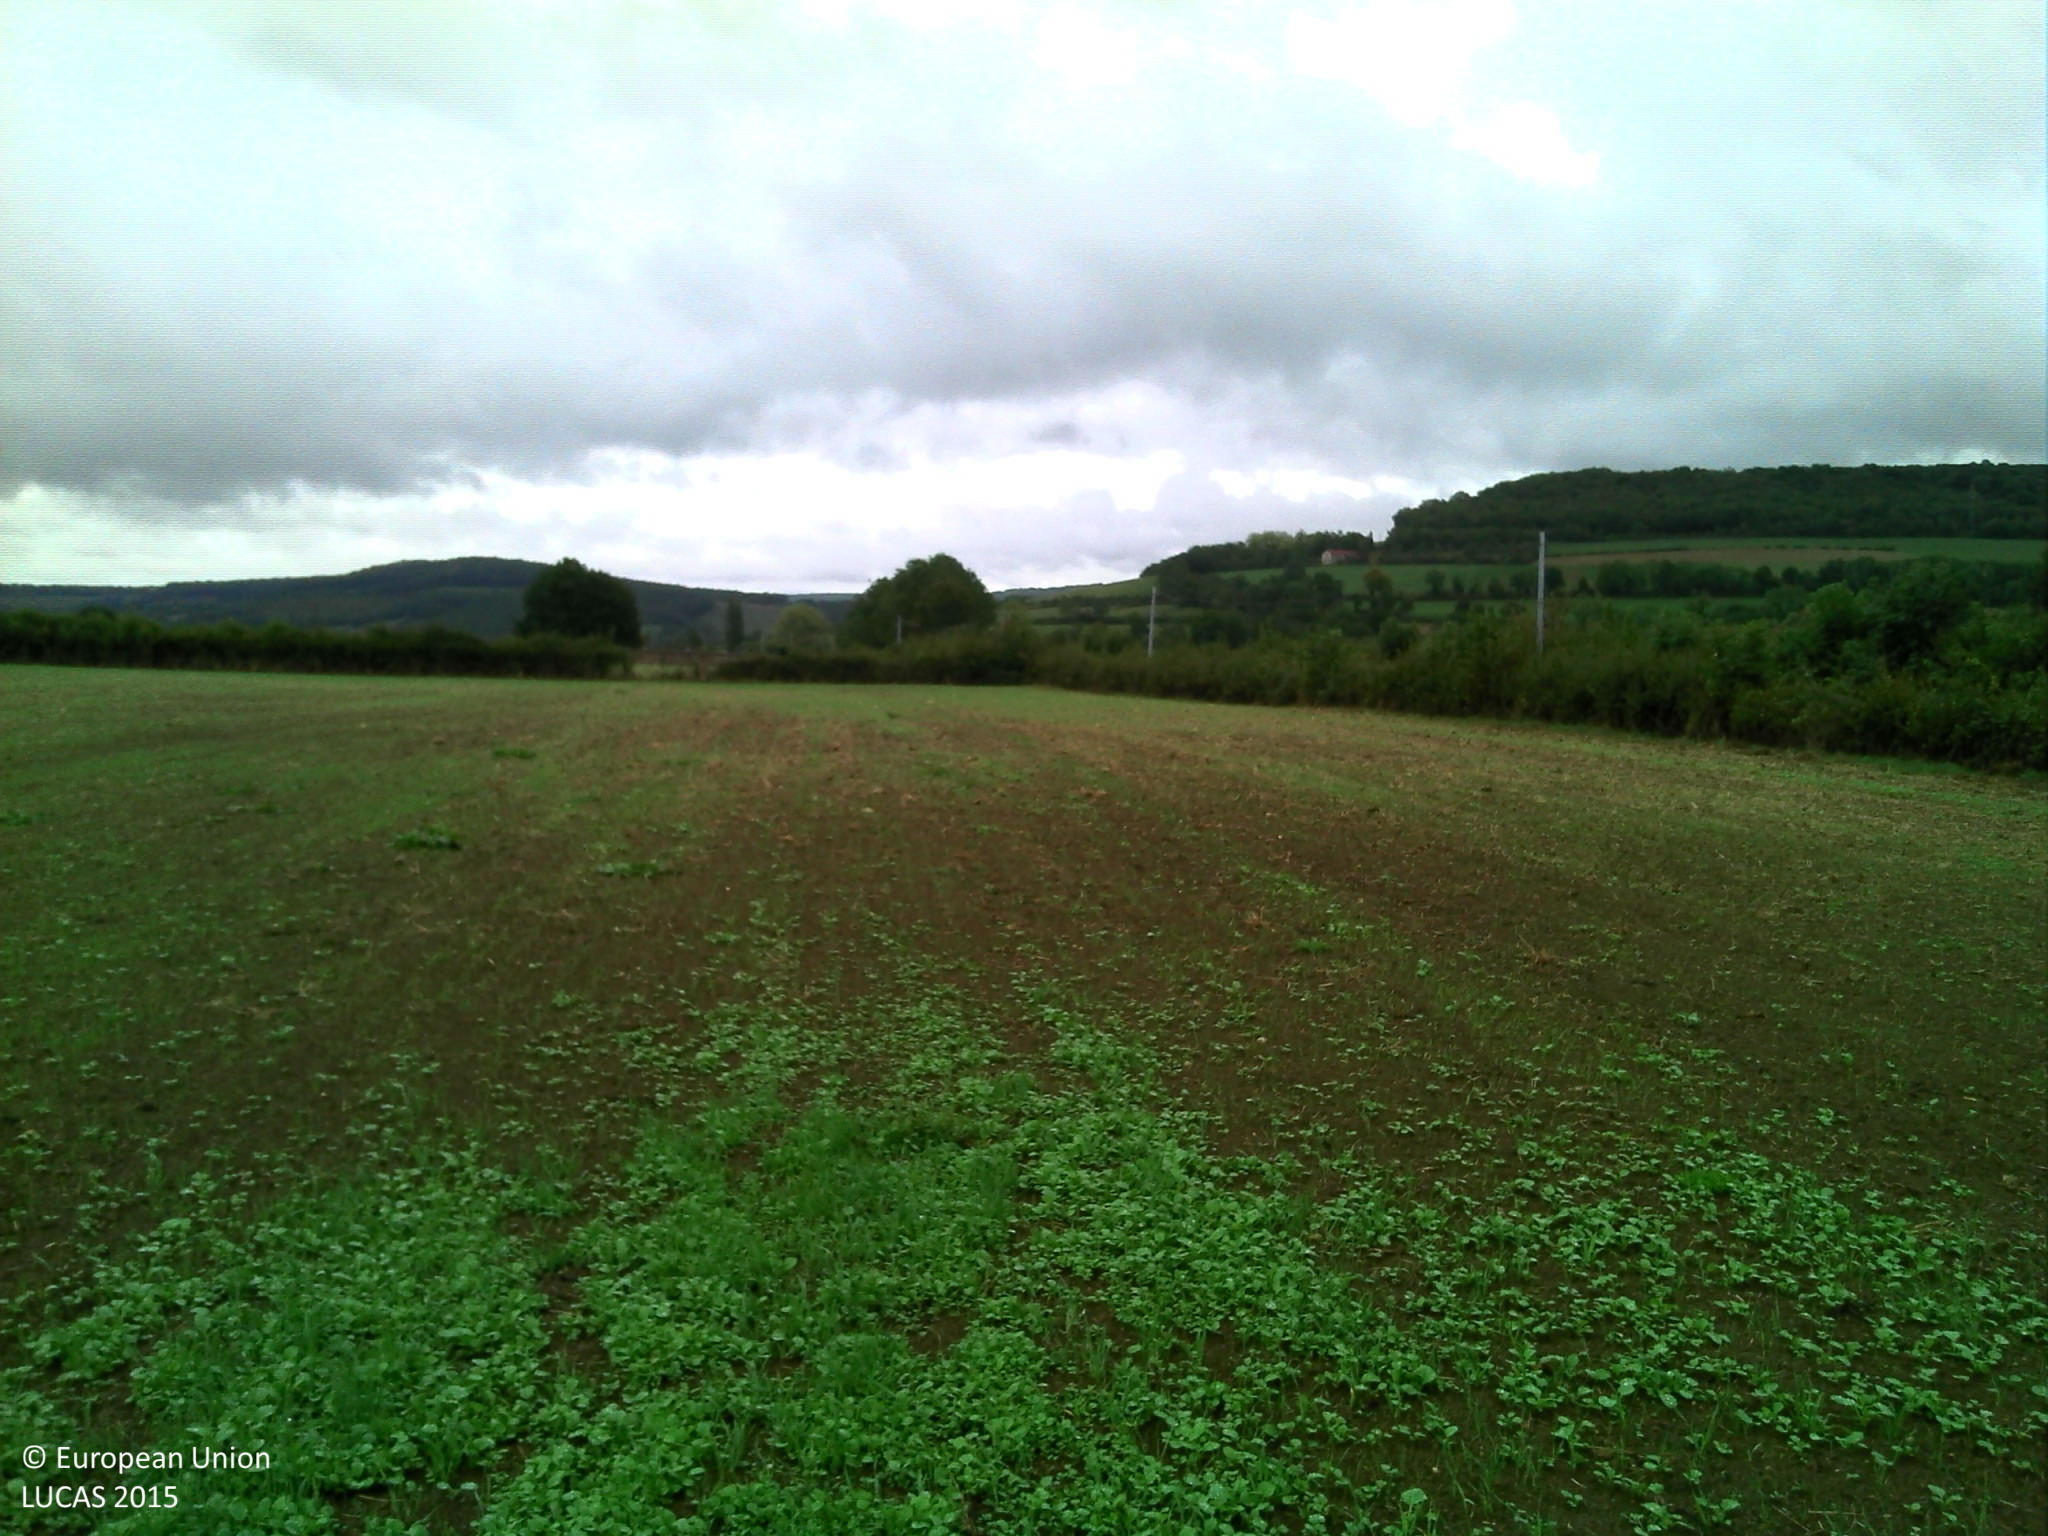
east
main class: Cropland
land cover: Rape and turnip rape
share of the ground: 25 - 50 %
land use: Agriculture (excluding fallow land and kitchen gardens)
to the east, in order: Rape and turnip rape; Fences; Managed hedges; Grassland without tree/shrub cover; Fences; Grassland with sparse tree/shrub cover; Tracks; Grassland with sparse tree/shrub cover
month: September
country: FR
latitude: 47.3264
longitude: 4.4552
